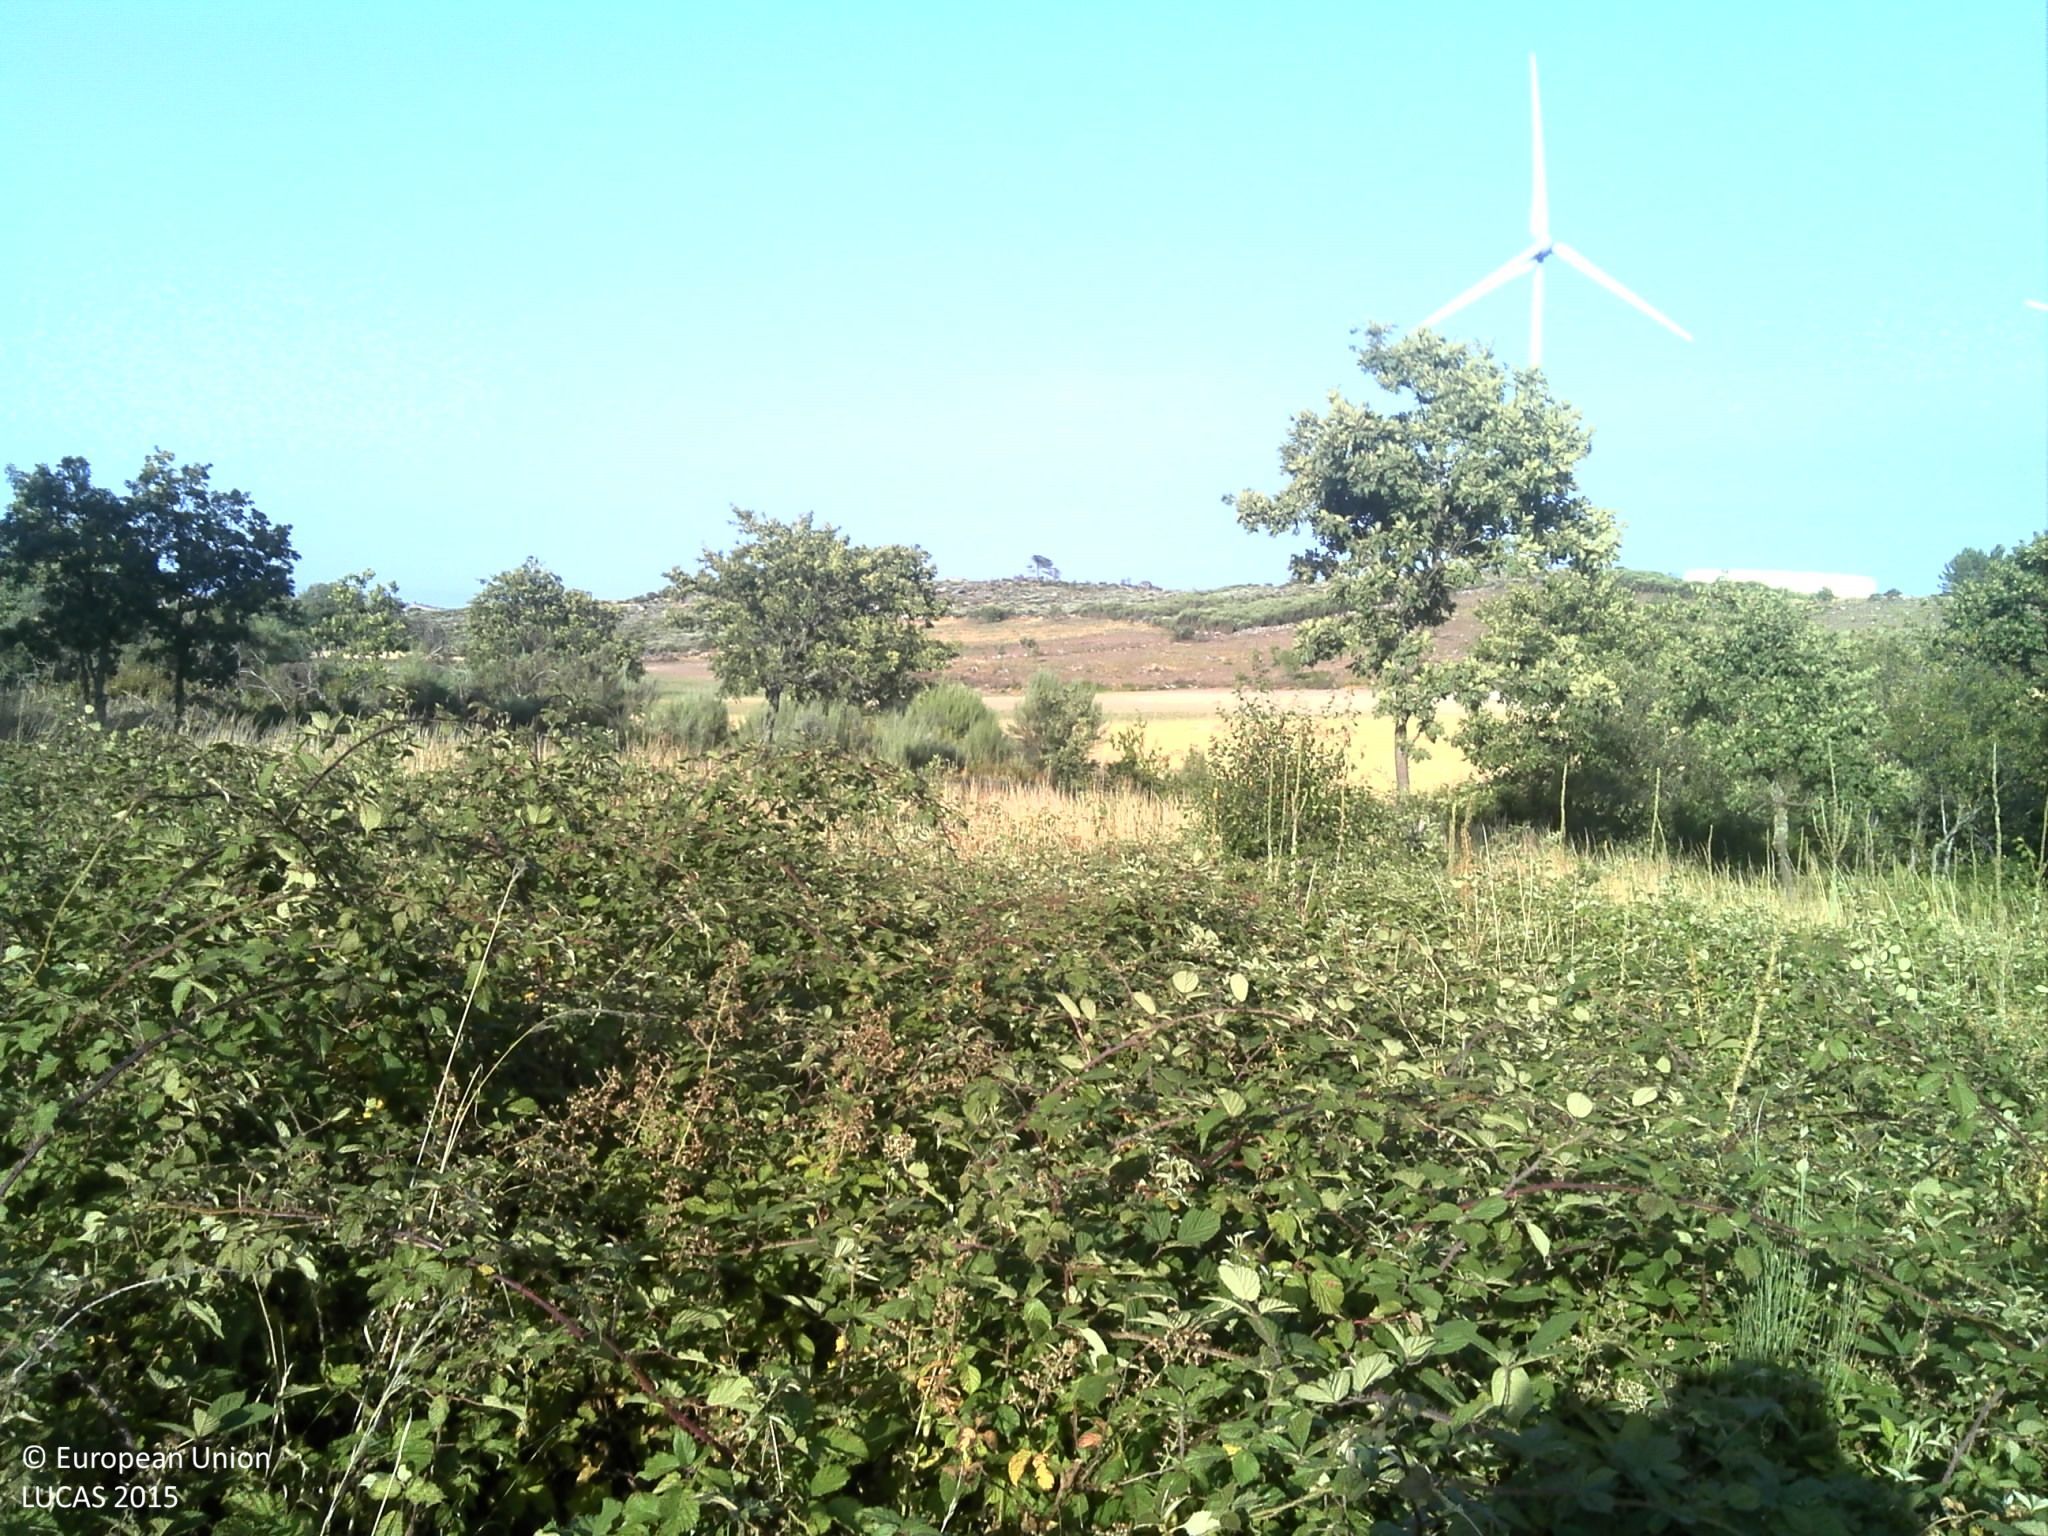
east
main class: Shrubland
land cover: Shrubland with sparse tree cover
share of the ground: 50 - 75 %
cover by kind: shrubs 55 %, unconsolidated bare surface 30 %, herbaceous plants 10 %, broadleaved forest trees 5 %
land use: Abandoned areas
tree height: > 5 m
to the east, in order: Shrubland with sparse tree cover; Rye; Other bare soil; Rye; Maize; Other bare soil; Shruby margins
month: July
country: PT
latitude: 40.8620
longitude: -7.3757
